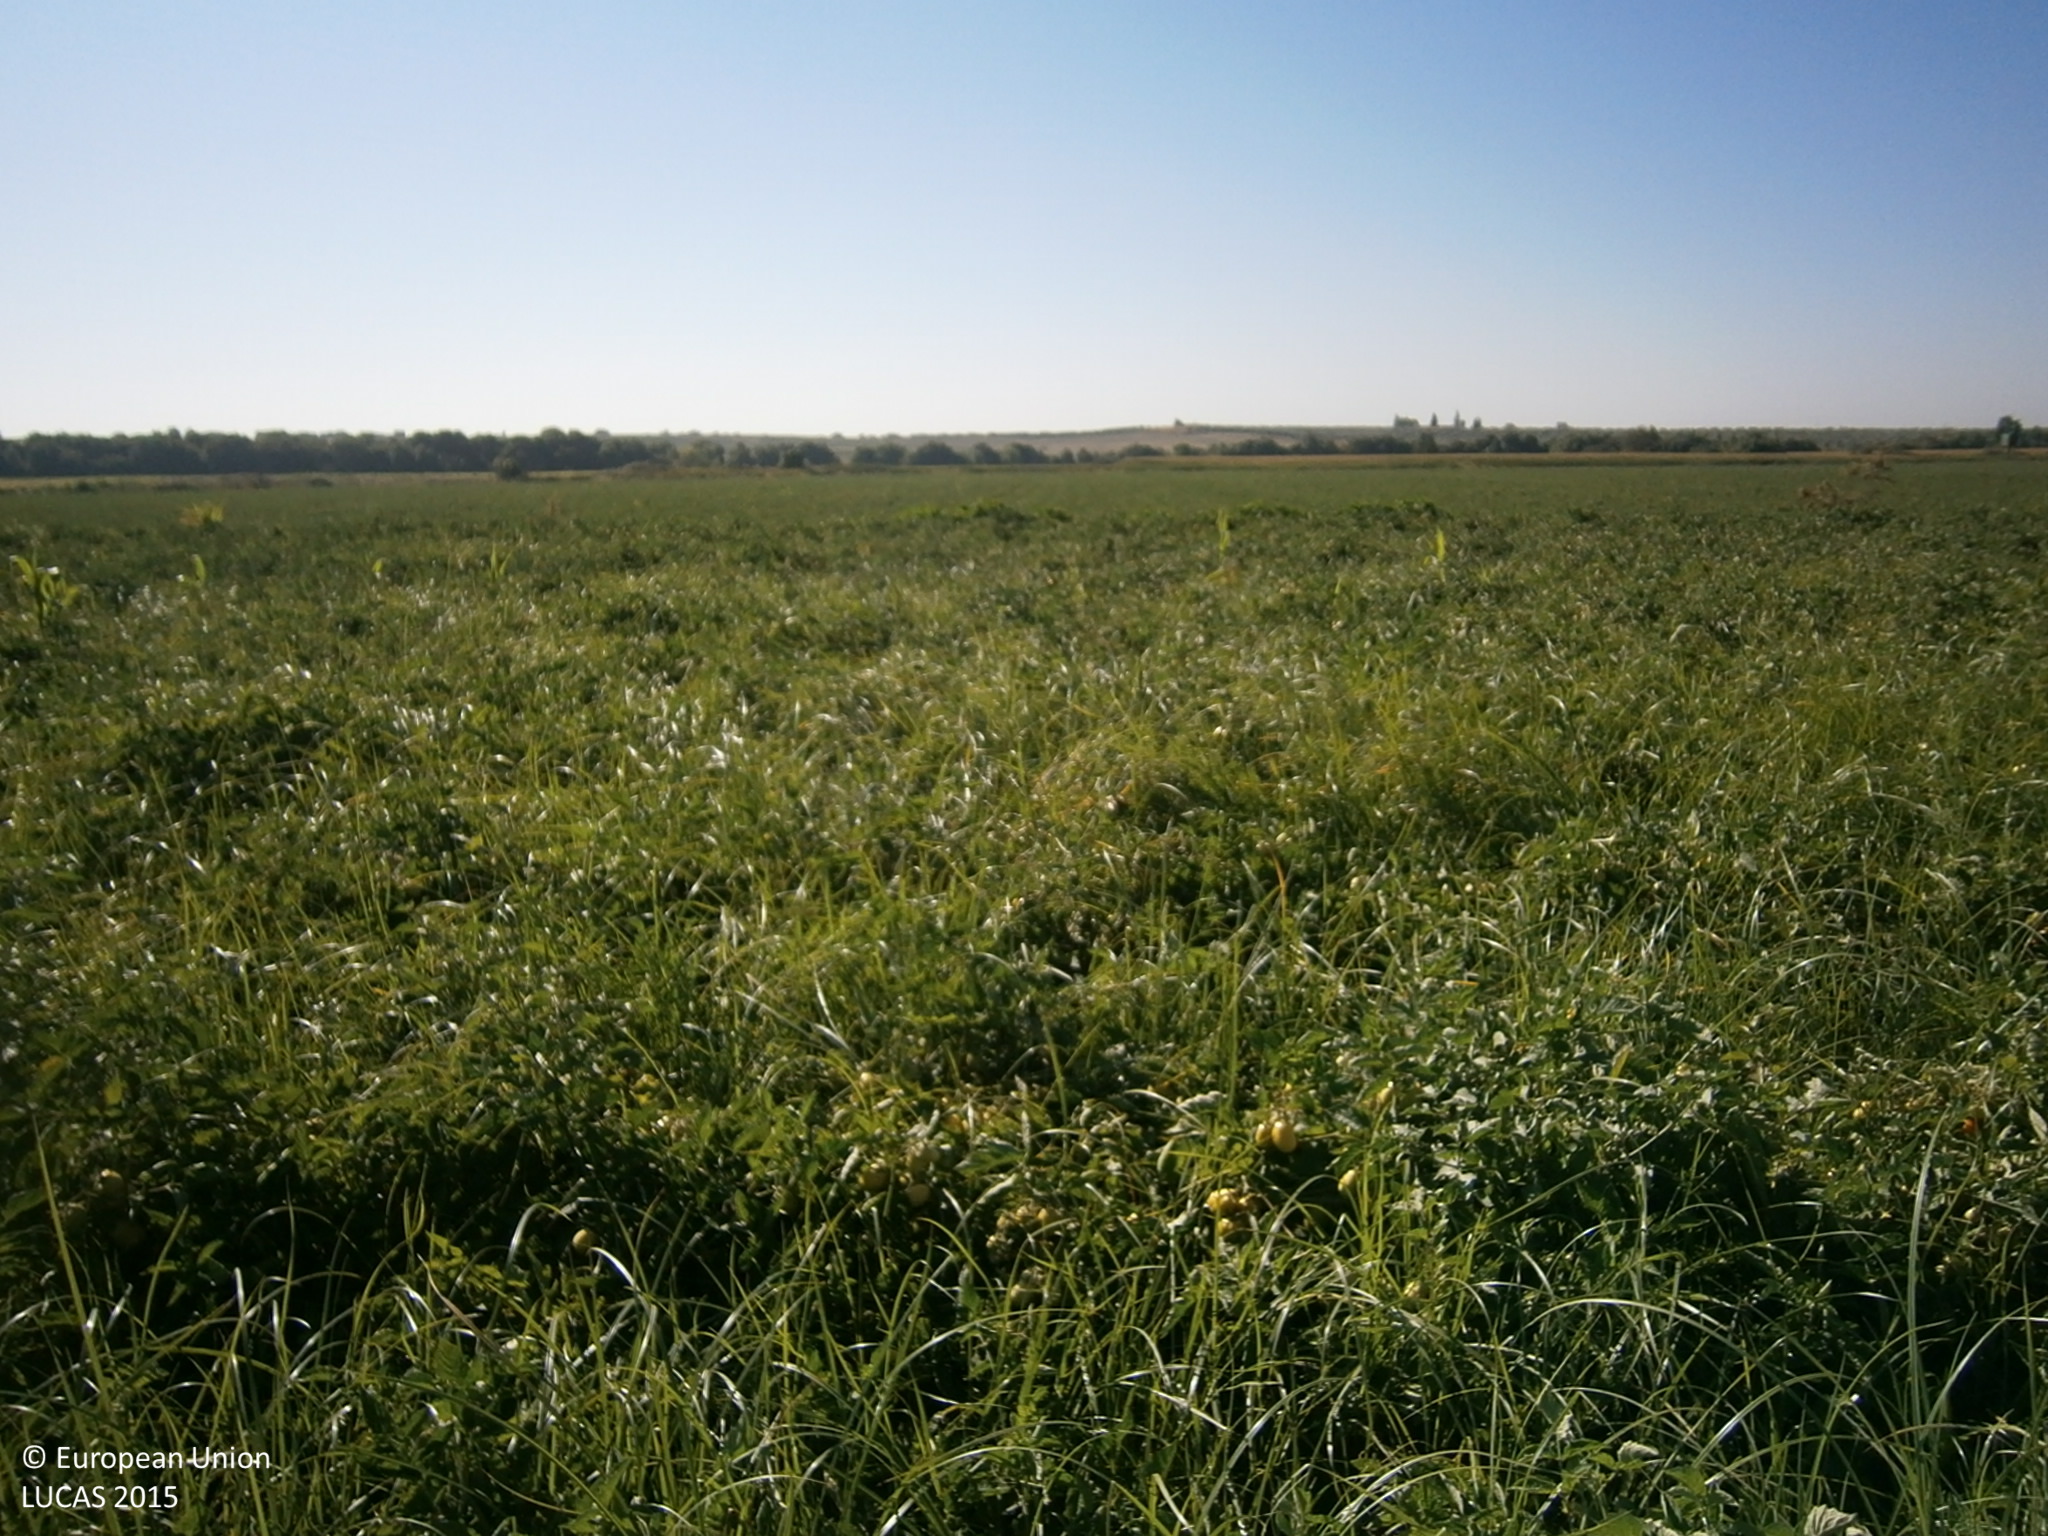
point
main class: Cropland
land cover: Tomatoes
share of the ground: > 75 %
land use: Agriculture (excluding fallow land and kitchen gardens)
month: July
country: ES
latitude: 38.9525
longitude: -6.8109
